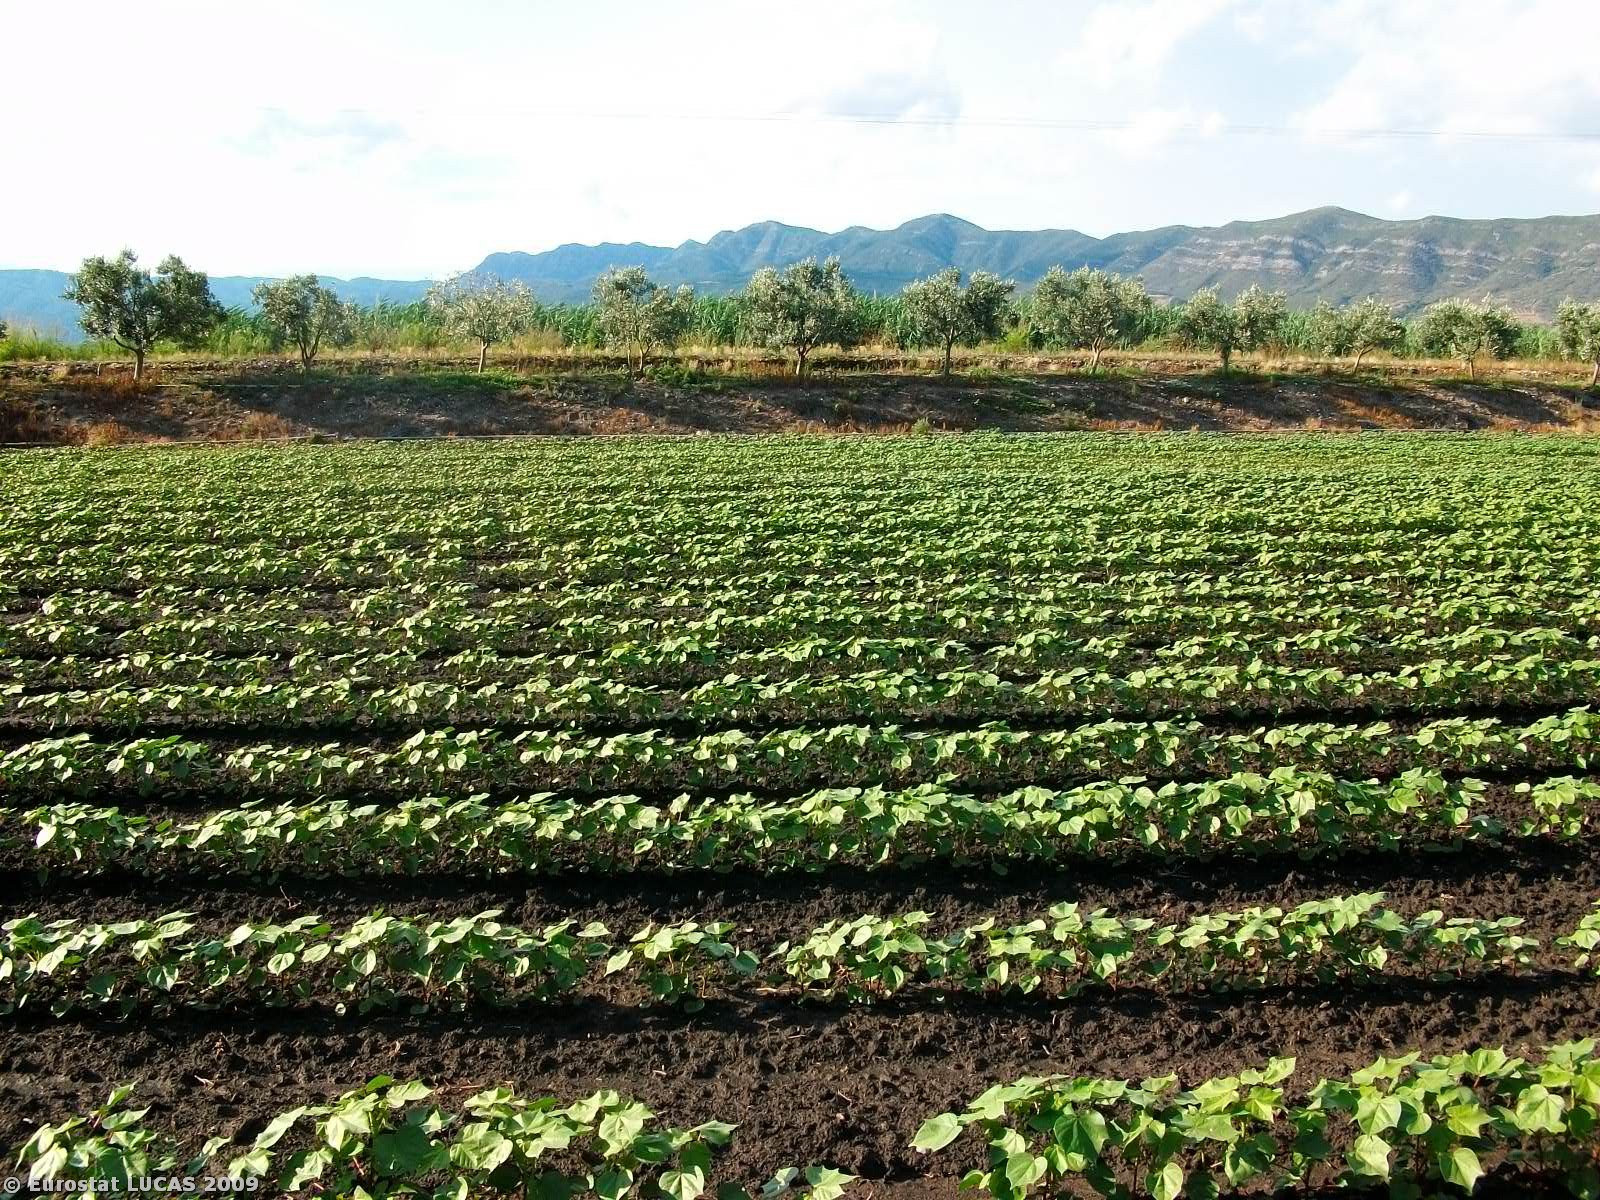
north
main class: Cropland
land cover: Cotton
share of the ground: 25 - 50 %
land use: Agriculture (excluding fallow land and kitchen gardens)
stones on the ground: < 10 %
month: June
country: GR
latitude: 38.3654
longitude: 21.4926
